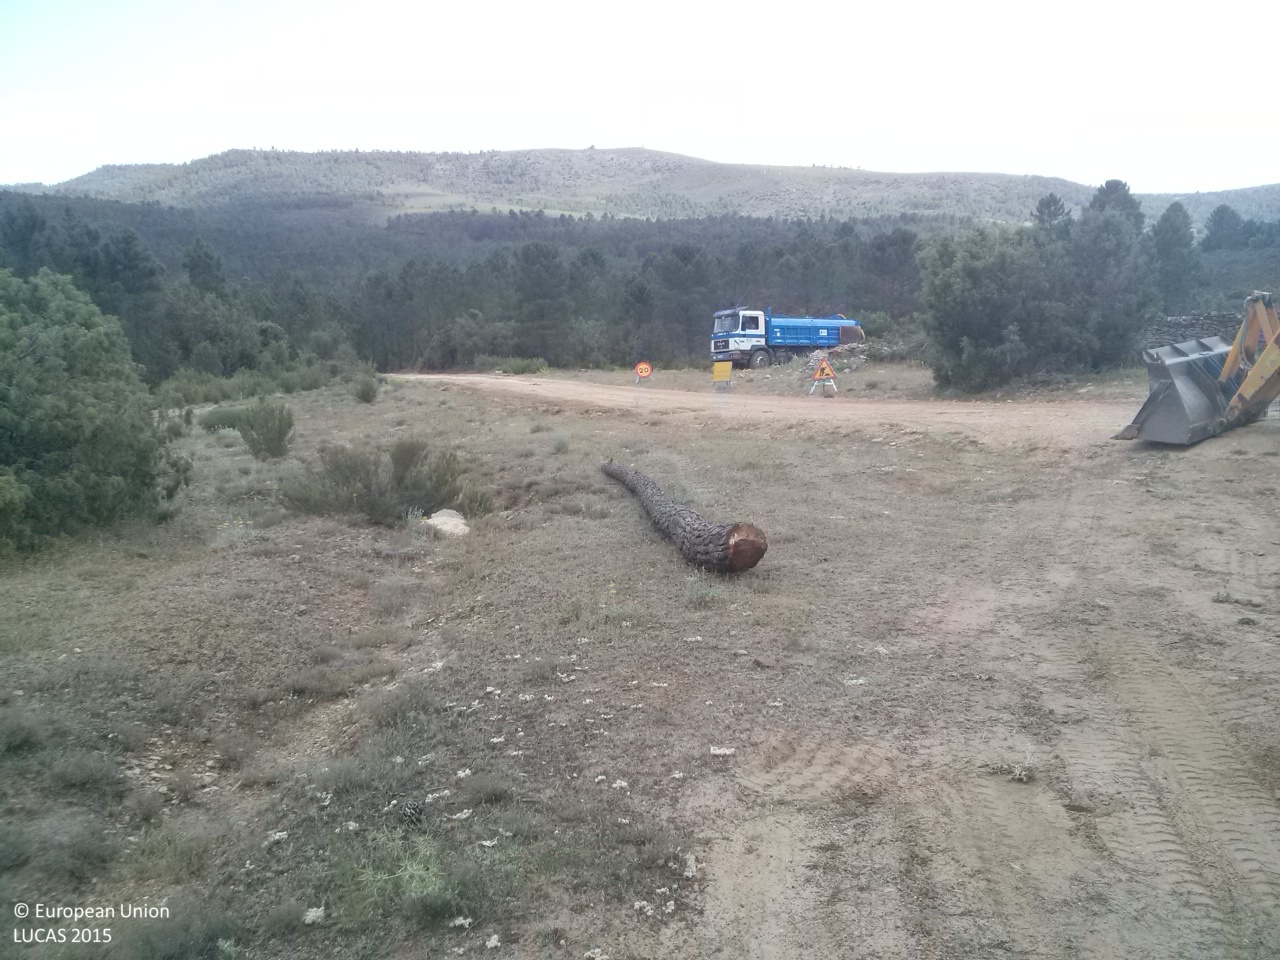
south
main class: Woodland
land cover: Pine dominated coniferous woodland
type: coniferous forest of the mediterranean region
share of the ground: 25 - 50 %
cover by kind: coniferous forest trees 30 %, shrubs 30 %, herbaceous plants 20 %, unconsolidated bare surface 20 %
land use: Forestry
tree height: > 5 m
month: June
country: ES
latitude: 39.9149
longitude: -1.6738
